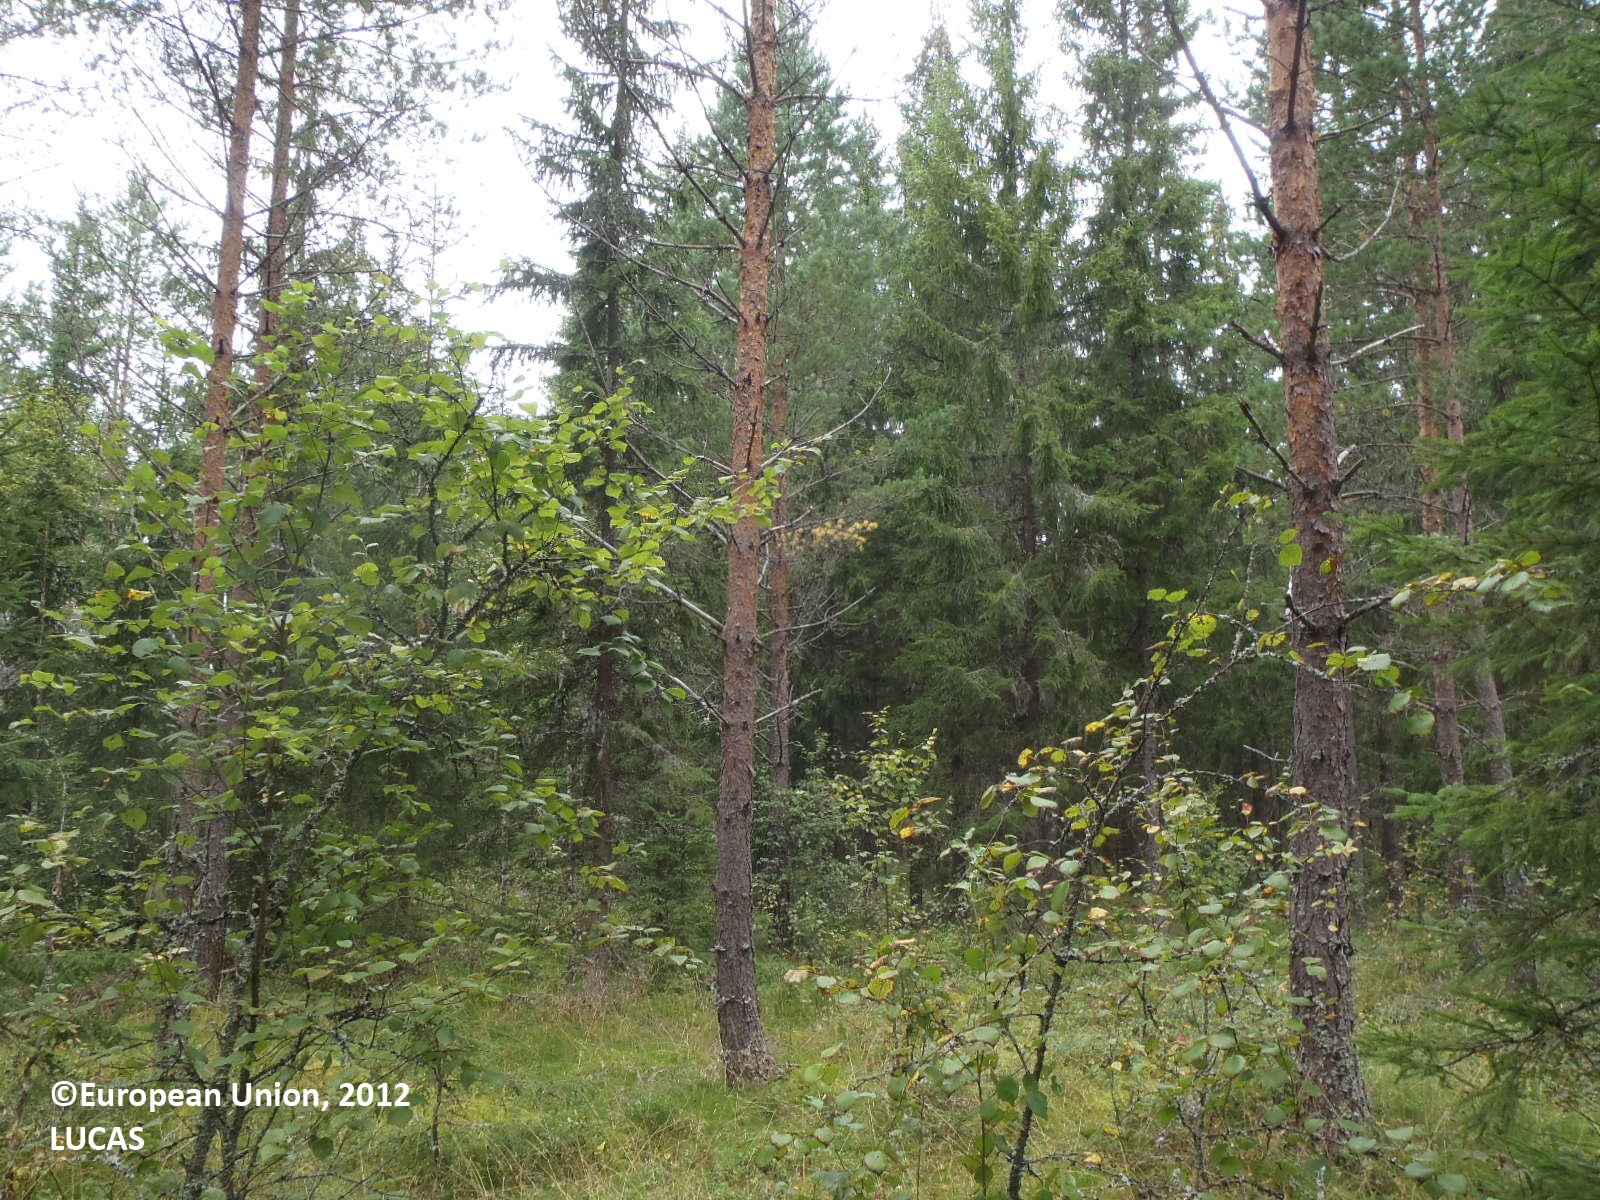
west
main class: Woodland
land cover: Pine dominated coniferous woodland
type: boreal forest
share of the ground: > 75 %
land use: Forestry
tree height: > 5 m
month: August
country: FI
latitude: 60.9138
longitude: 21.9169
